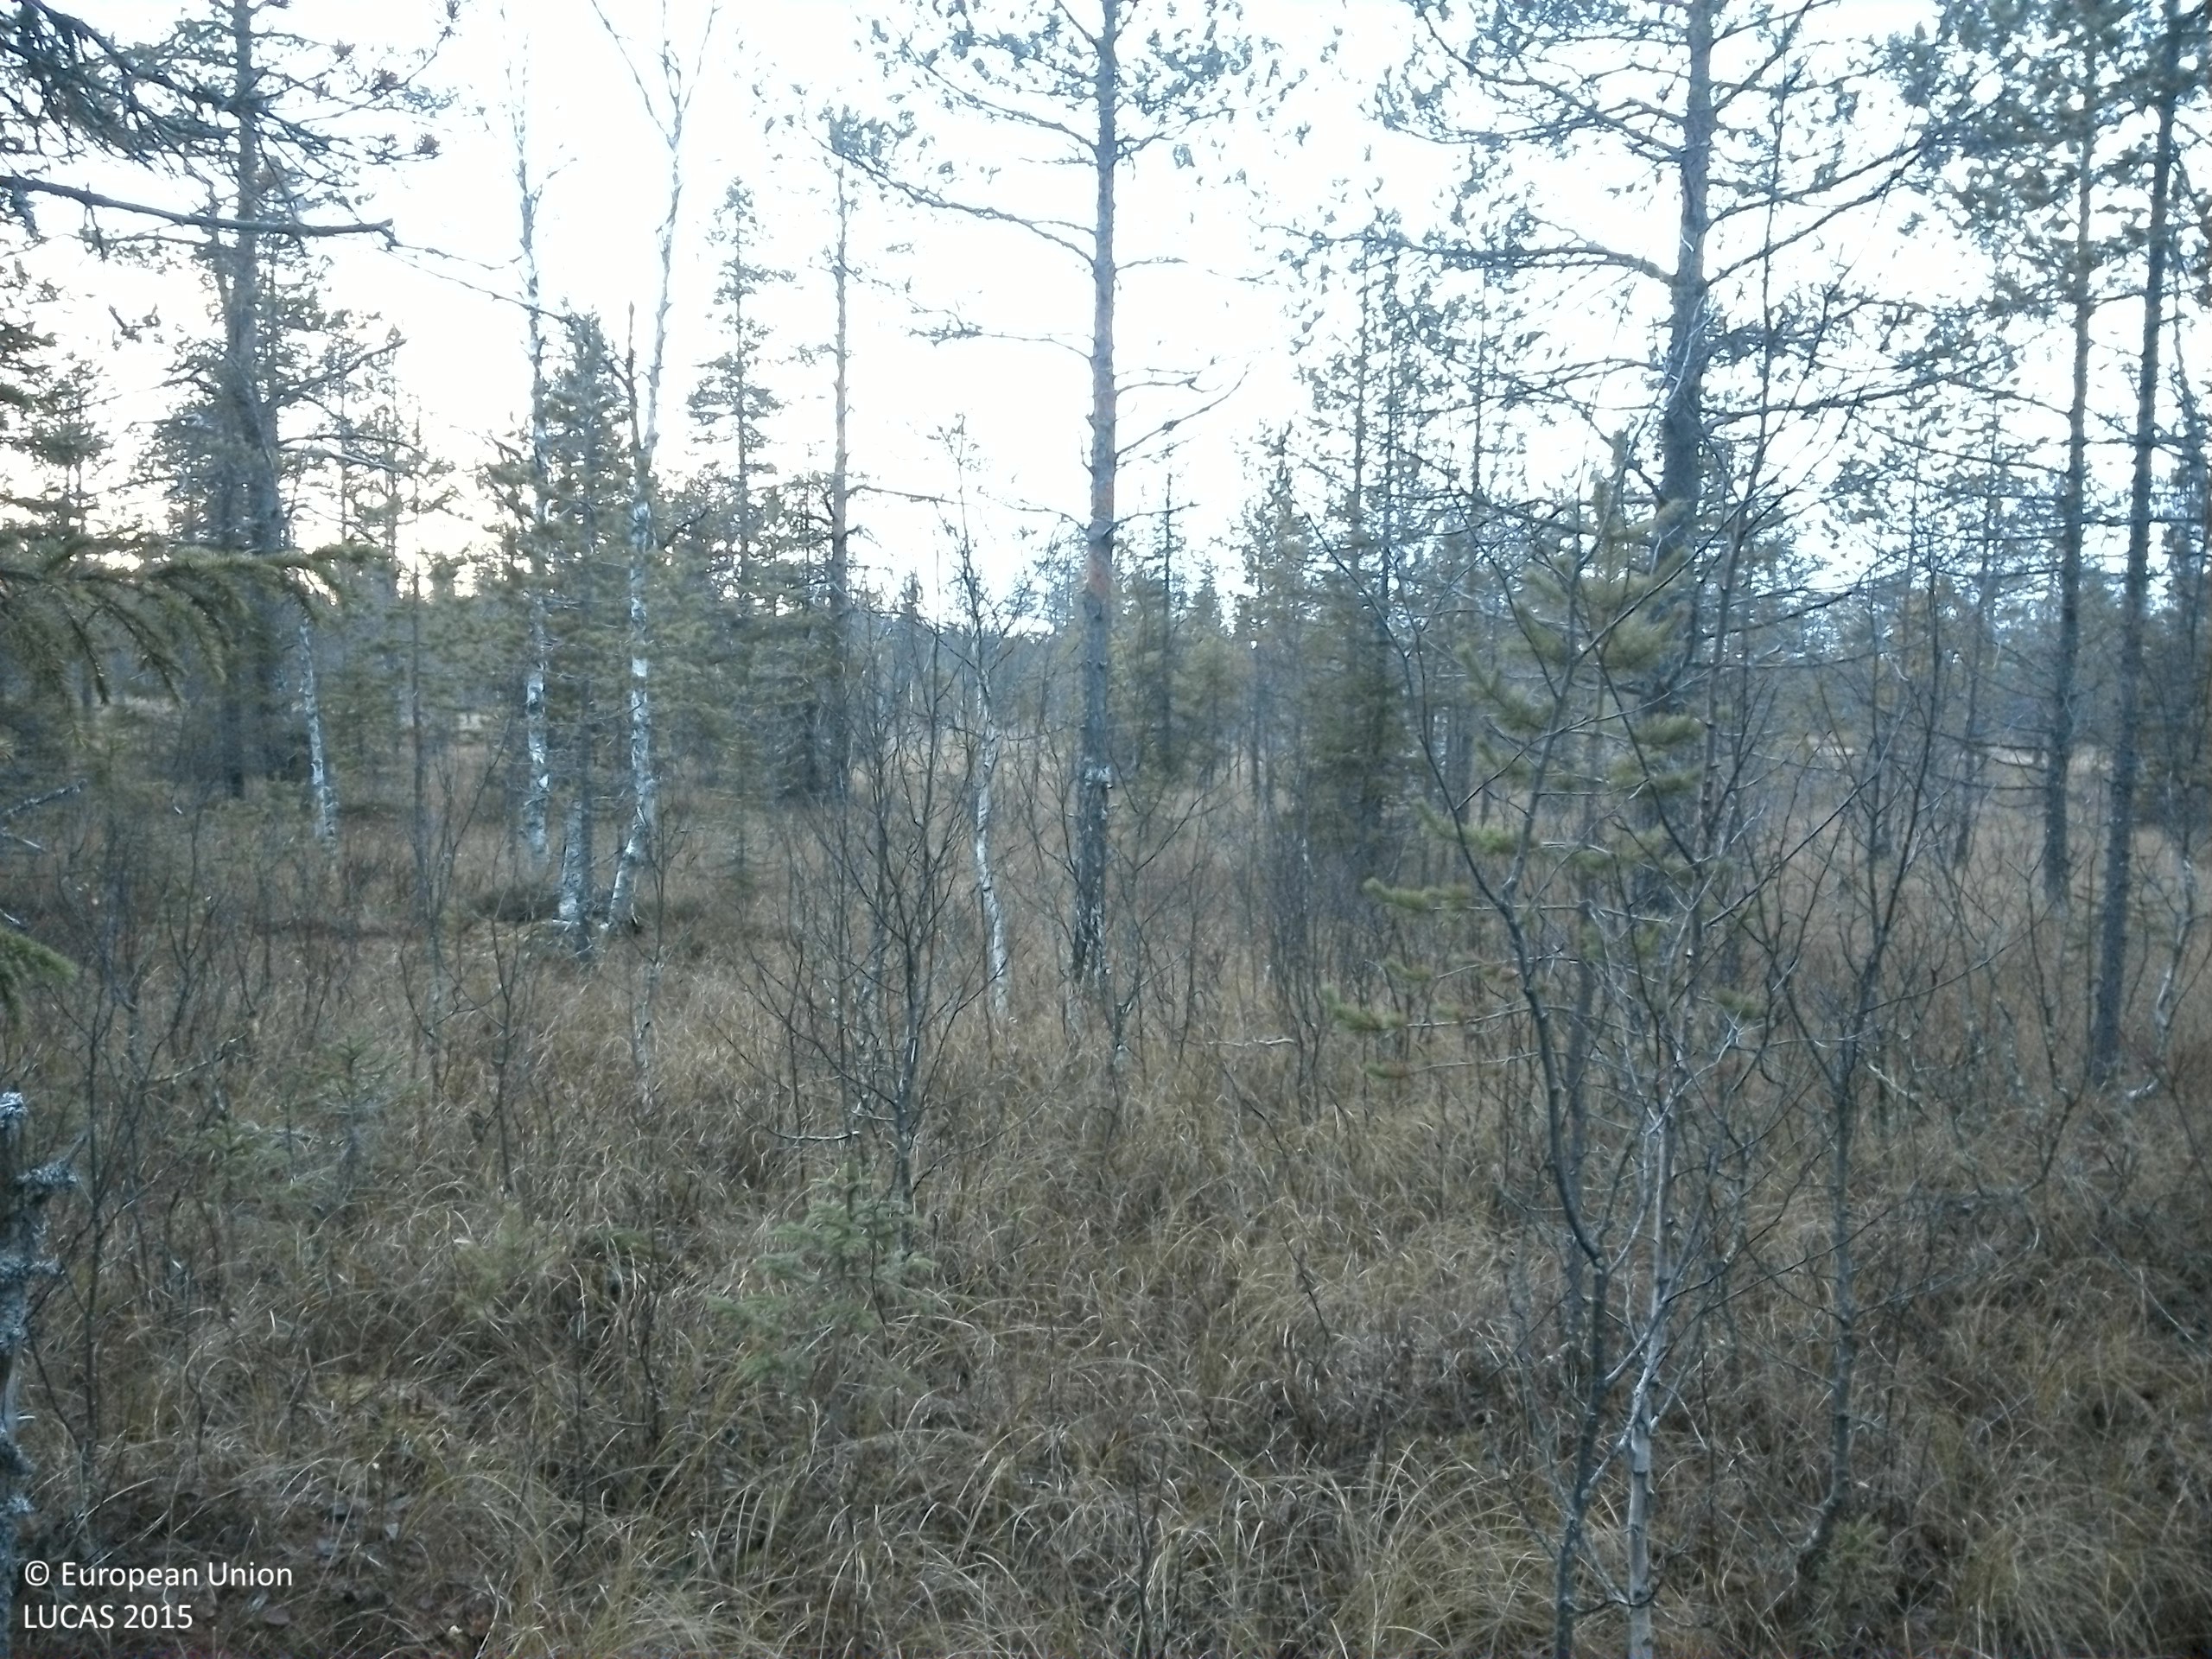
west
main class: Woodland
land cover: Pine dominated mixed woodland
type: mire and swamp forests
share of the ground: 25 - 50 %
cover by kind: coniferous forest trees 25 %, herbaceous plants 25 %, lichens and mosses 25 %, broadleaved forest trees 20 %, shrubs 5 %
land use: Forestry
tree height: > 5 m
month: October
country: SE
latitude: 63.7817
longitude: 15.3909
